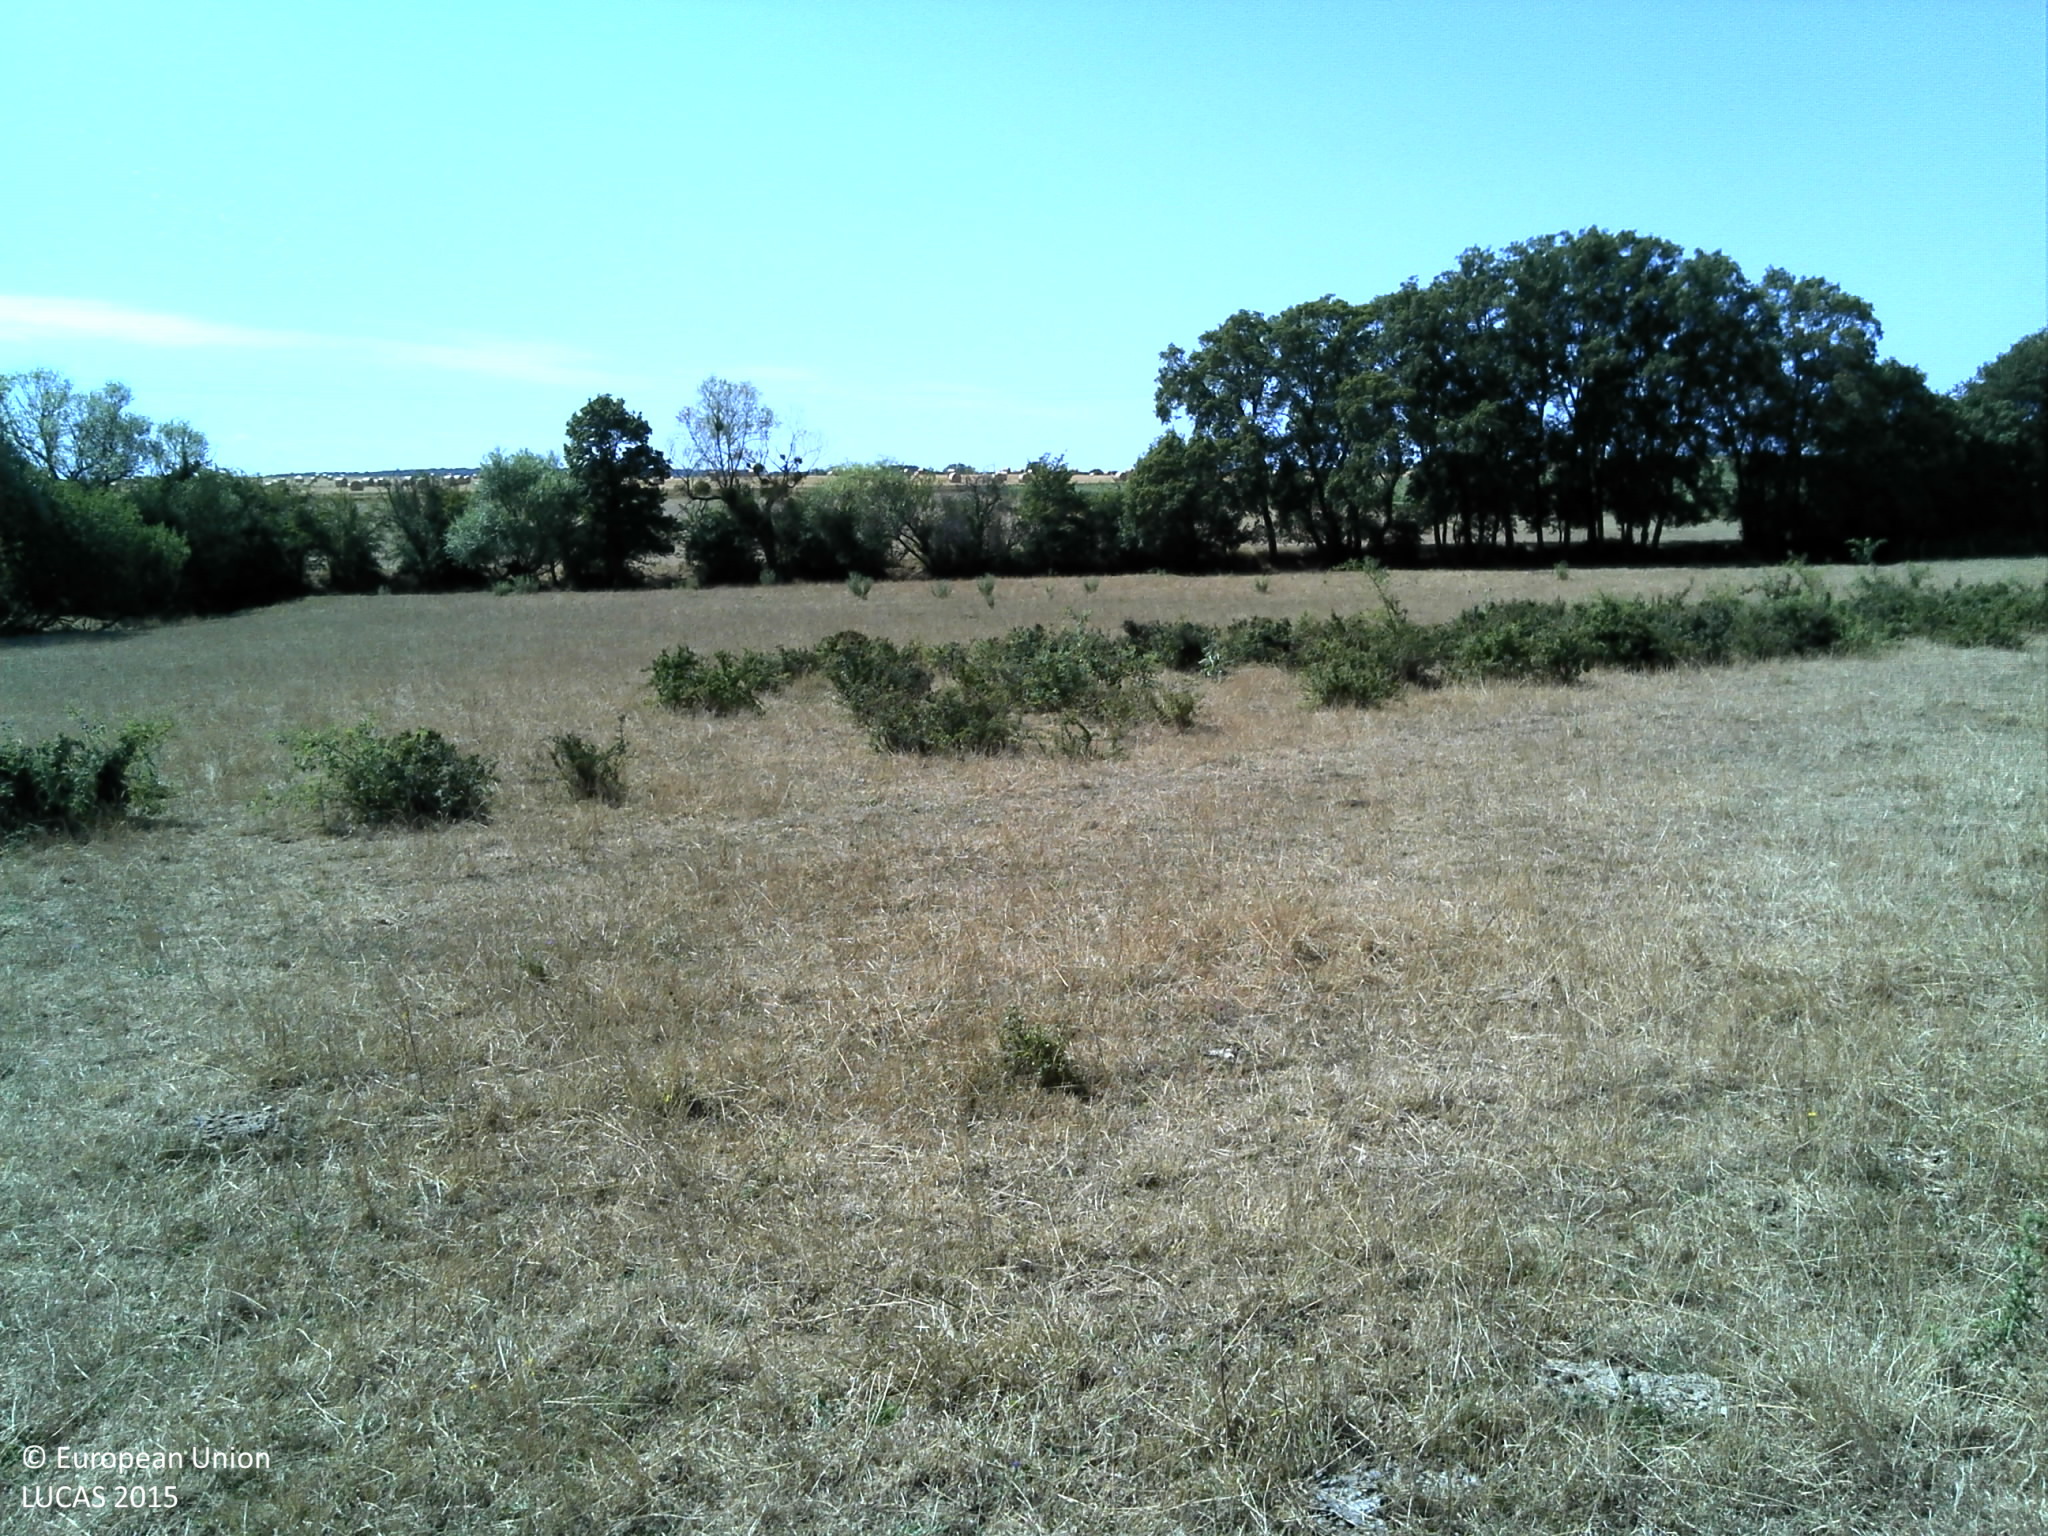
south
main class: Grassland
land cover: Grassland with sparse tree/shrub cover
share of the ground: > 75 %
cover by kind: herbaceous plants 95 %, broadleaved forest trees 5 %
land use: Agriculture (excluding fallow land and kitchen gardens)
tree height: < 5 m
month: July
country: FR
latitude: 48.3329
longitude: 6.0478
